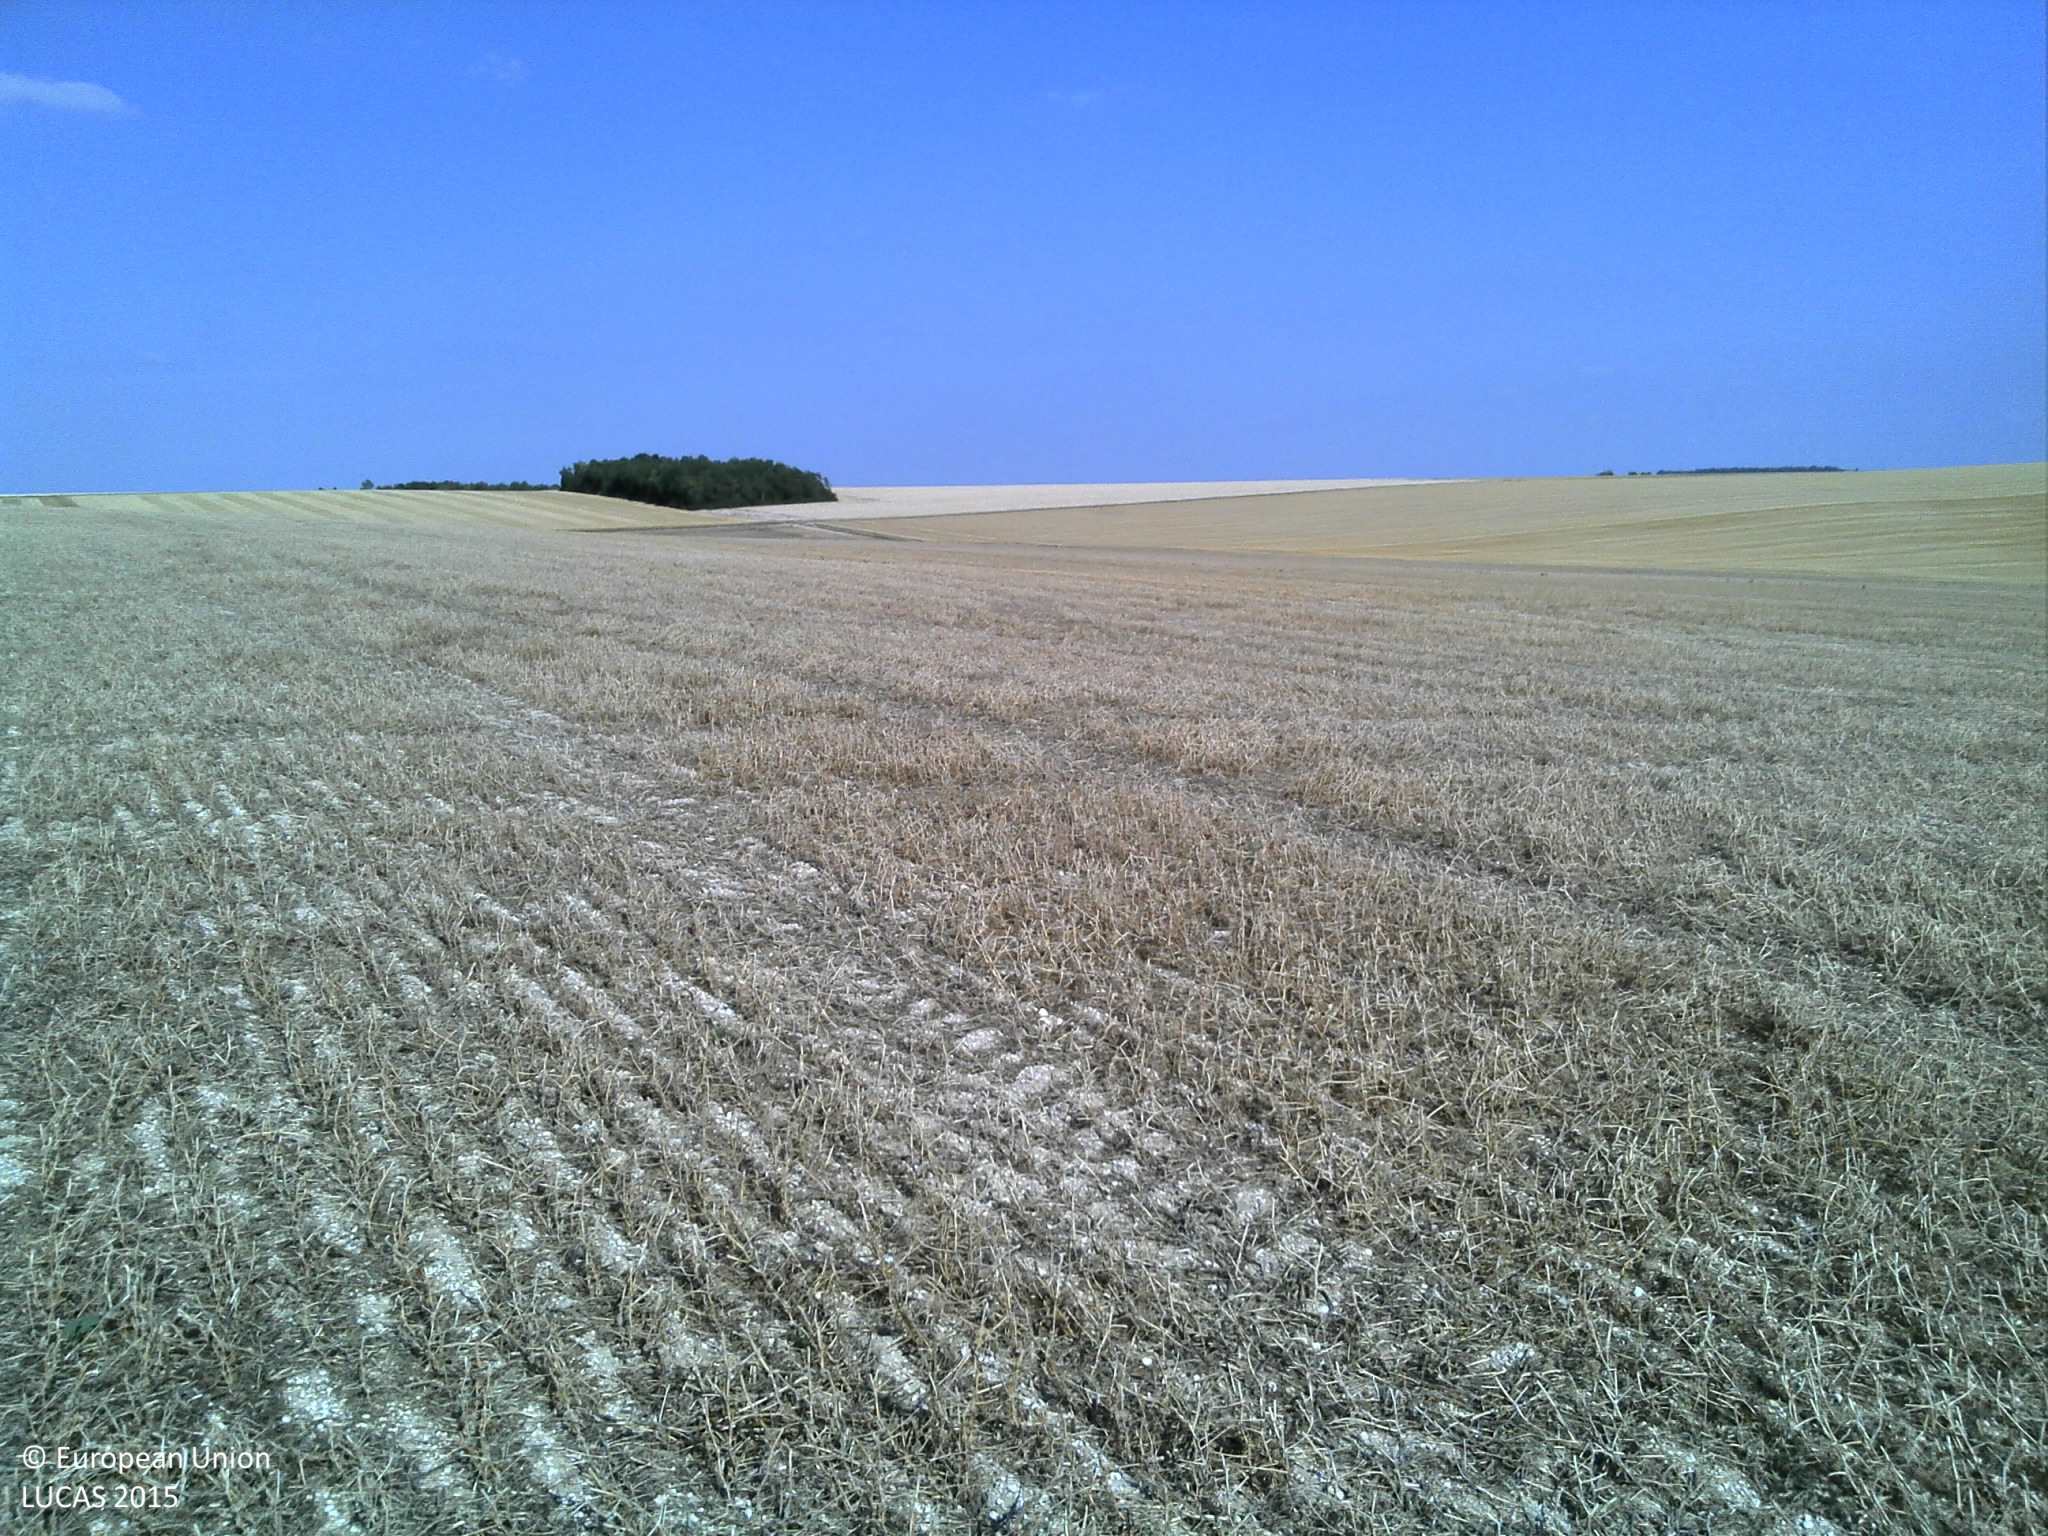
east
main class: Cropland
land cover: Dry pulses
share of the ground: > 75 %
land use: Agriculture (excluding fallow land and kitchen gardens)
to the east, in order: Dry pulses
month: August
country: FR
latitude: 48.9402
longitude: 4.6316
